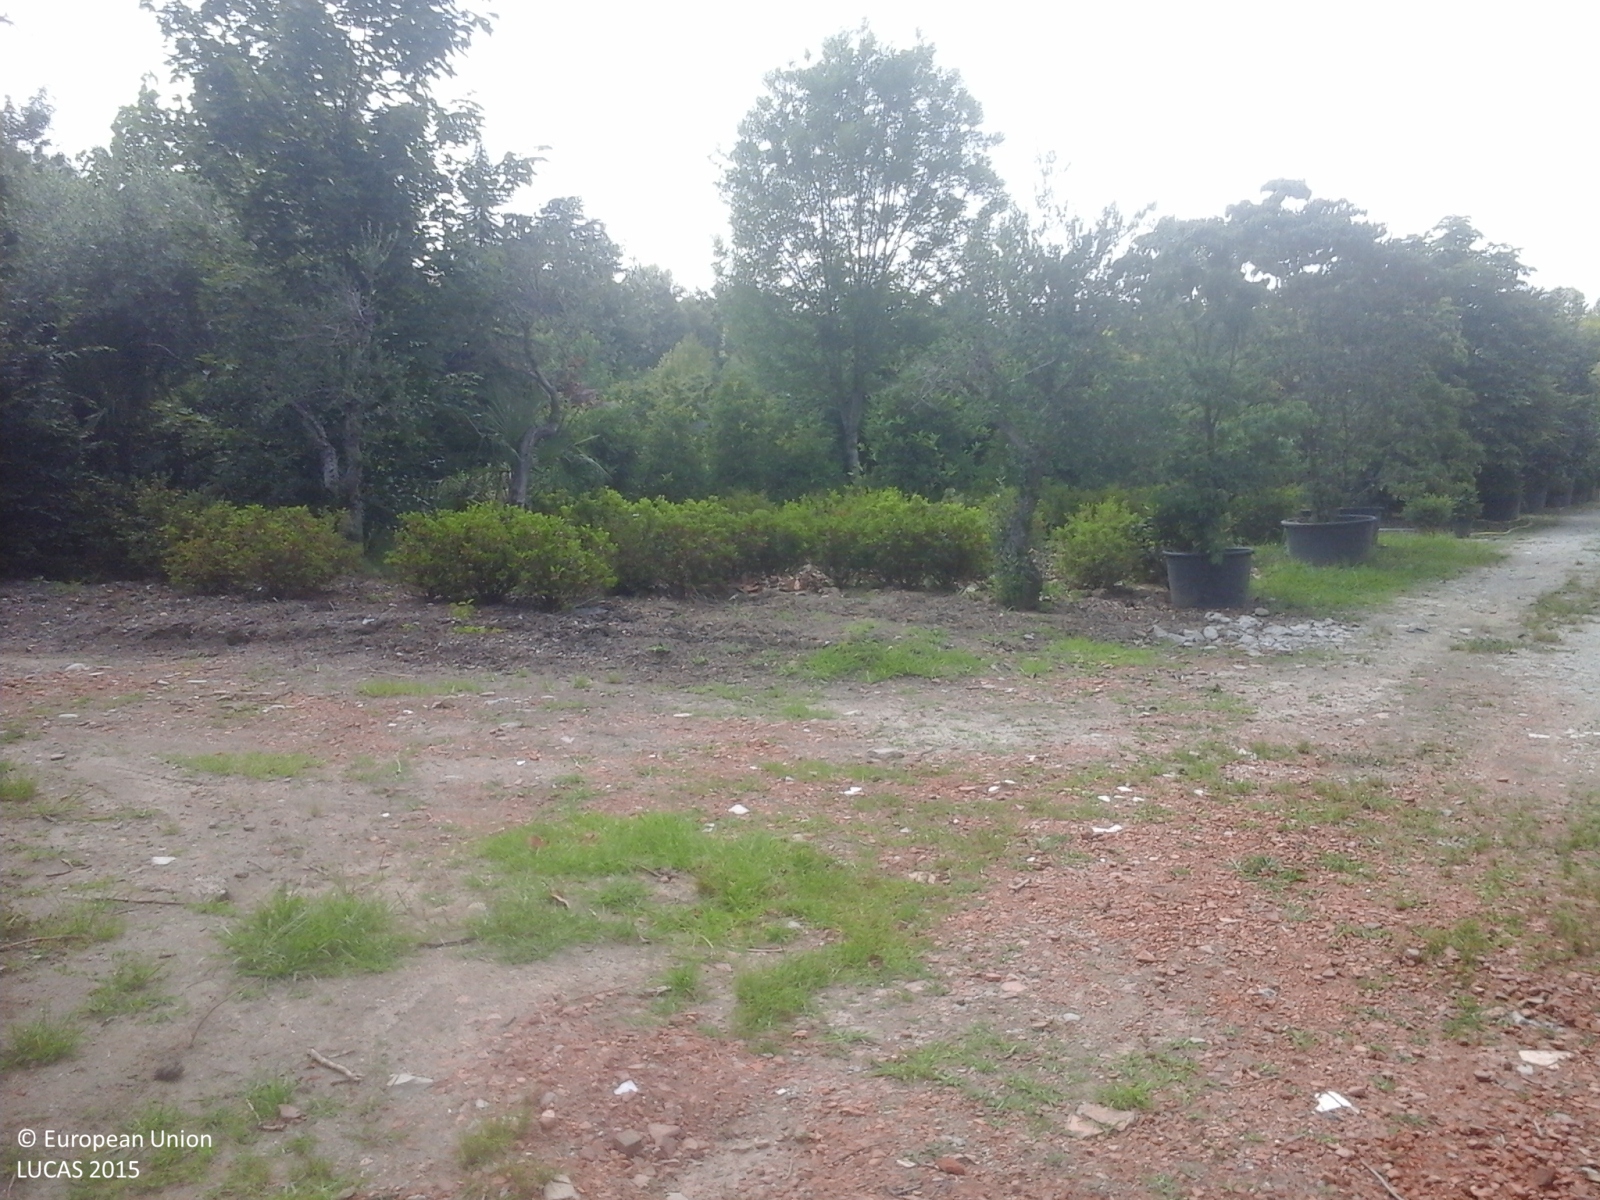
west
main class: Cropland
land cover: Nurseries
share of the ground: > 75 %
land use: Agriculture (excluding fallow land and kitchen gardens)
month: June
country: IT
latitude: 45.7189
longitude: 9.3971
